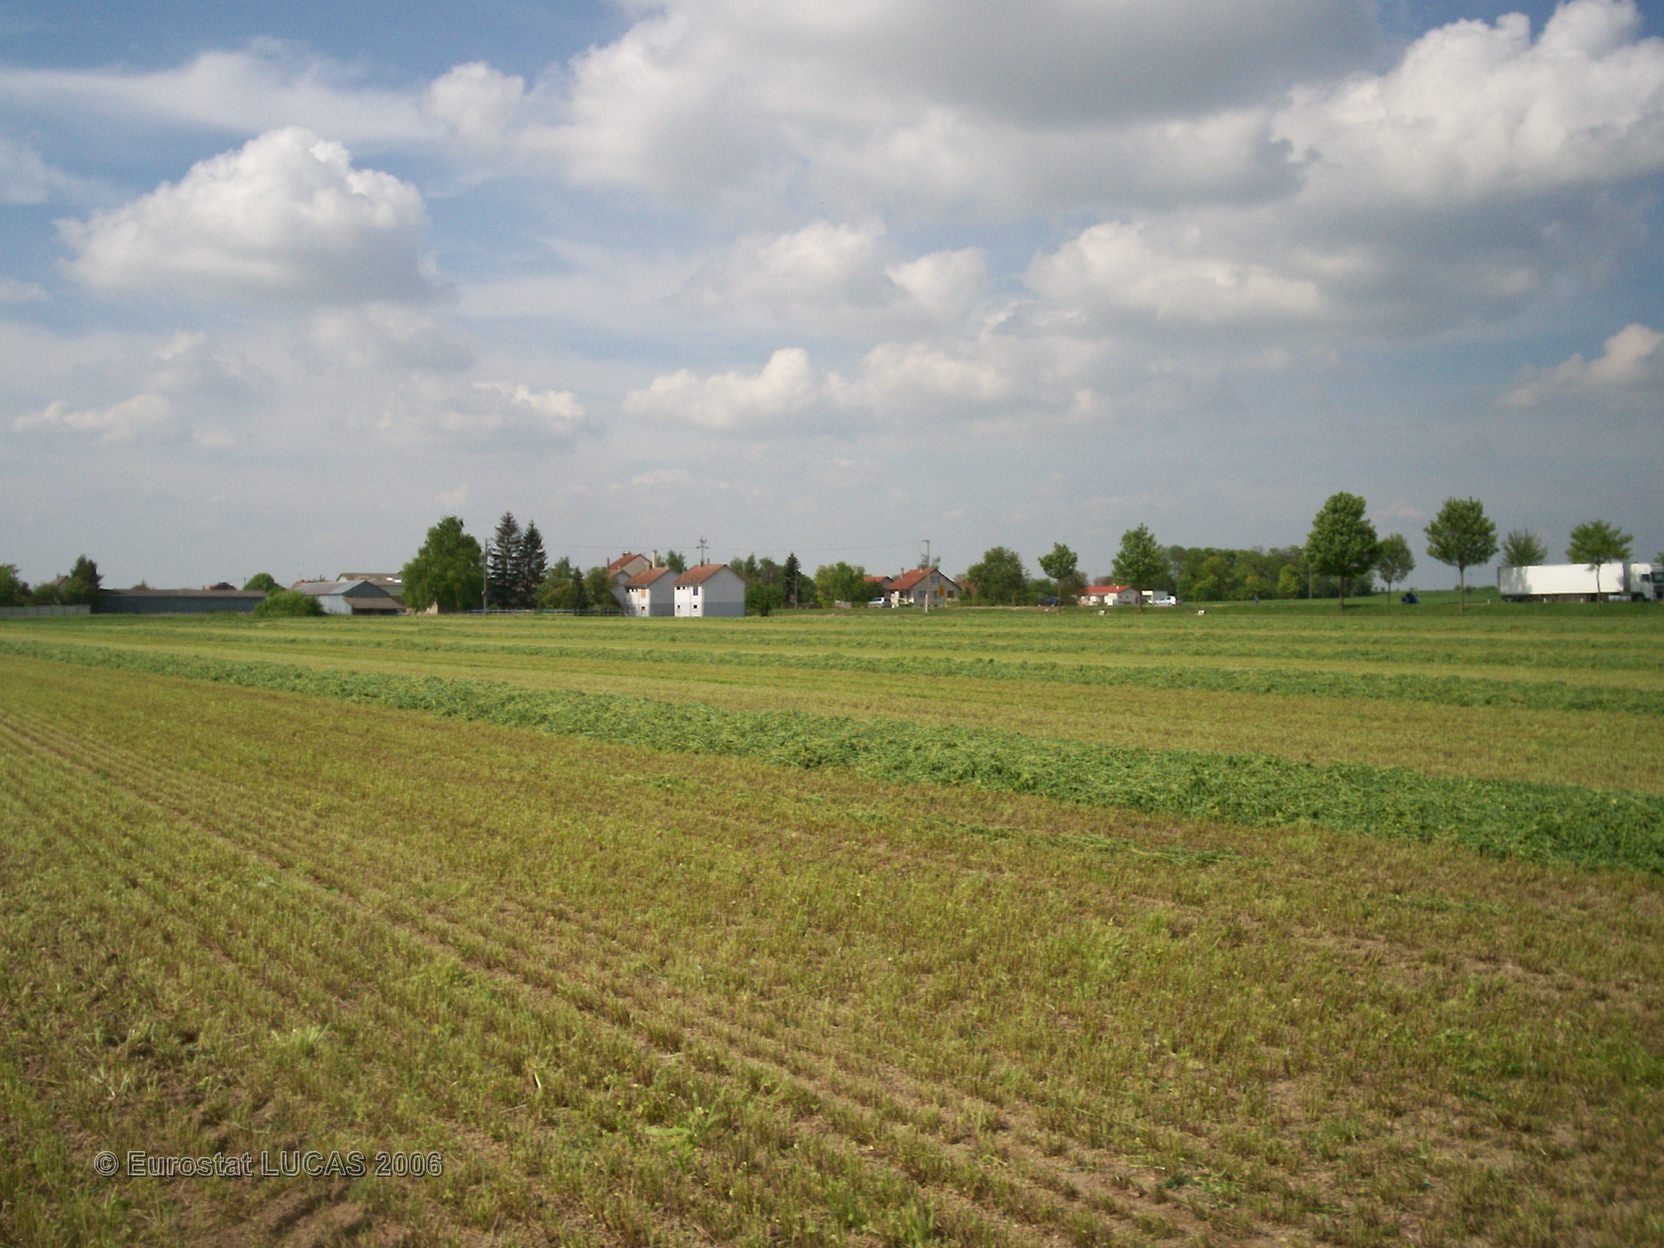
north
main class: Cropland
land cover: Lucerne
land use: Agriculture (excluding fallow land and kitchen gardens)
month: May
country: FR
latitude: 48.8951
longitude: 4.4451
